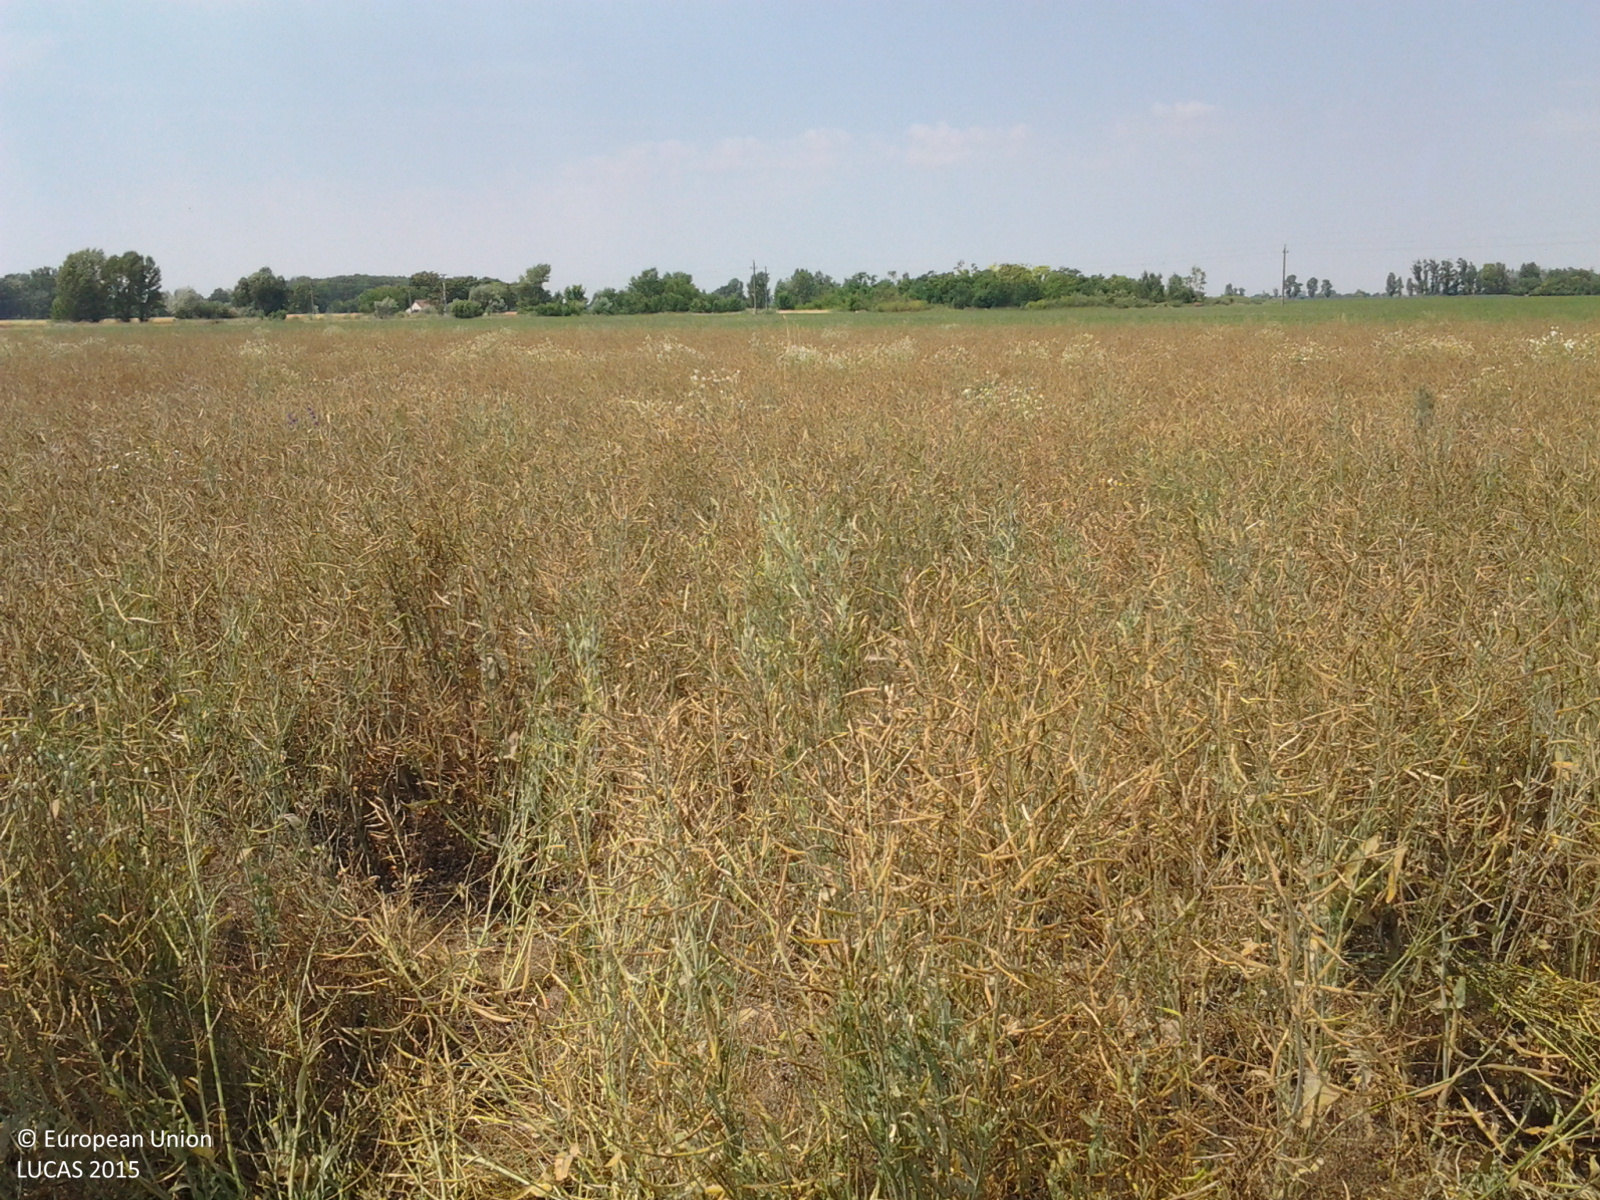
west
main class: Cropland
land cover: Rape and turnip rape
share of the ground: > 75 %
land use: Agriculture (excluding fallow land and kitchen gardens)
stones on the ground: < 10 %
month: July
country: HU
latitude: 47.5237
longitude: 19.8930
